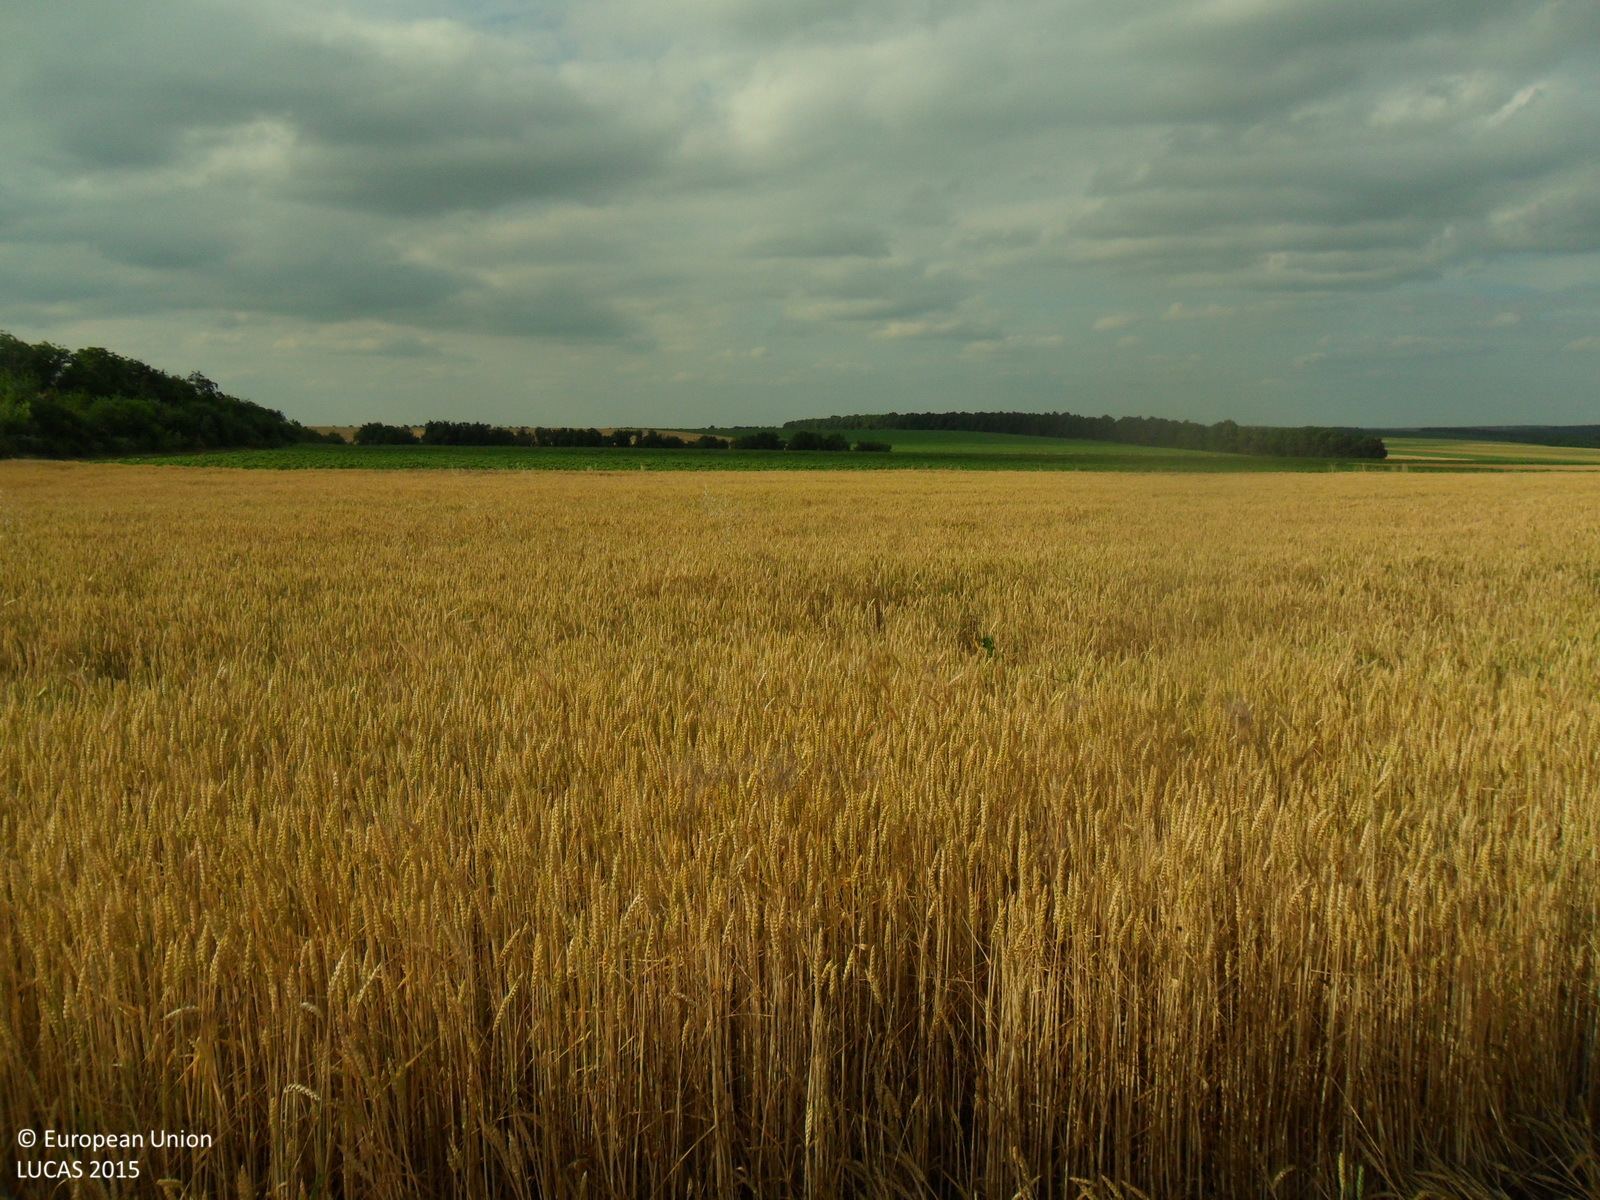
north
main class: Cropland
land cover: Common wheat
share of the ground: > 75 %
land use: Agriculture (excluding fallow land and kitchen gardens)
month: June
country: BG
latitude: 43.7914
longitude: 26.8313
